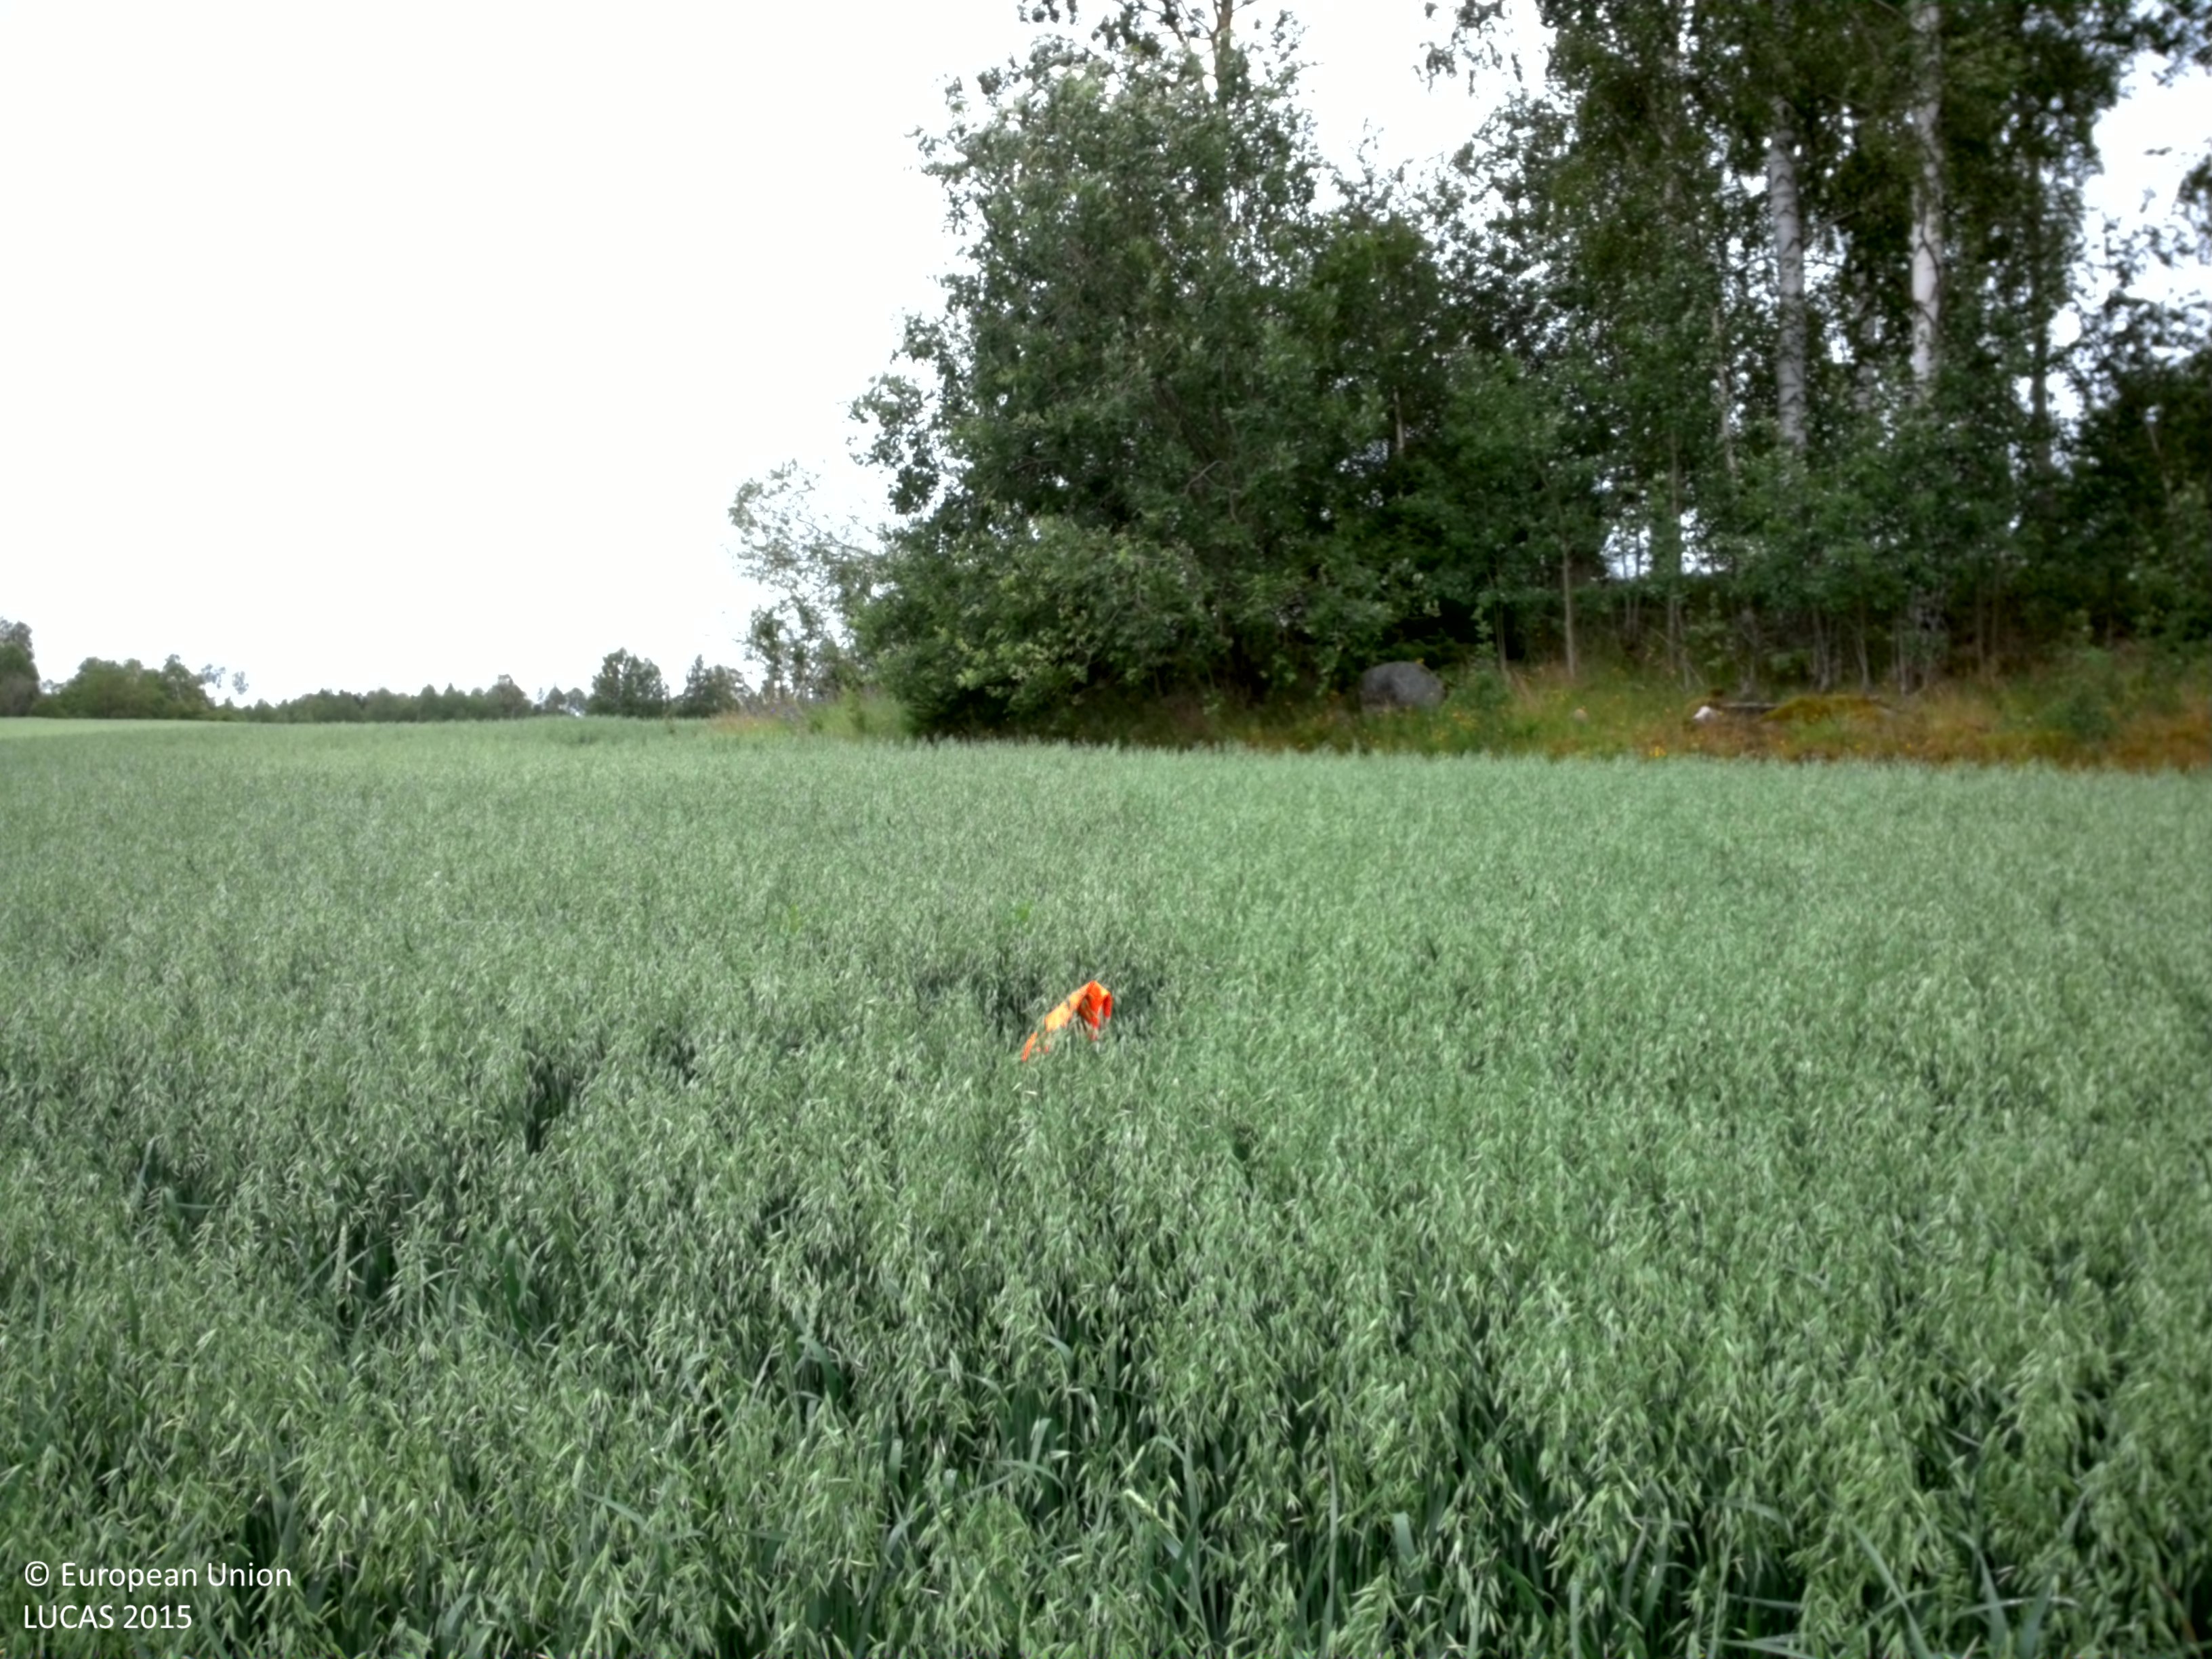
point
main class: Cropland
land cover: Oats
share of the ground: > 75 %
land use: Agriculture (excluding fallow land and kitchen gardens)
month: July
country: SE
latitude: 58.6732
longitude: 15.3219
